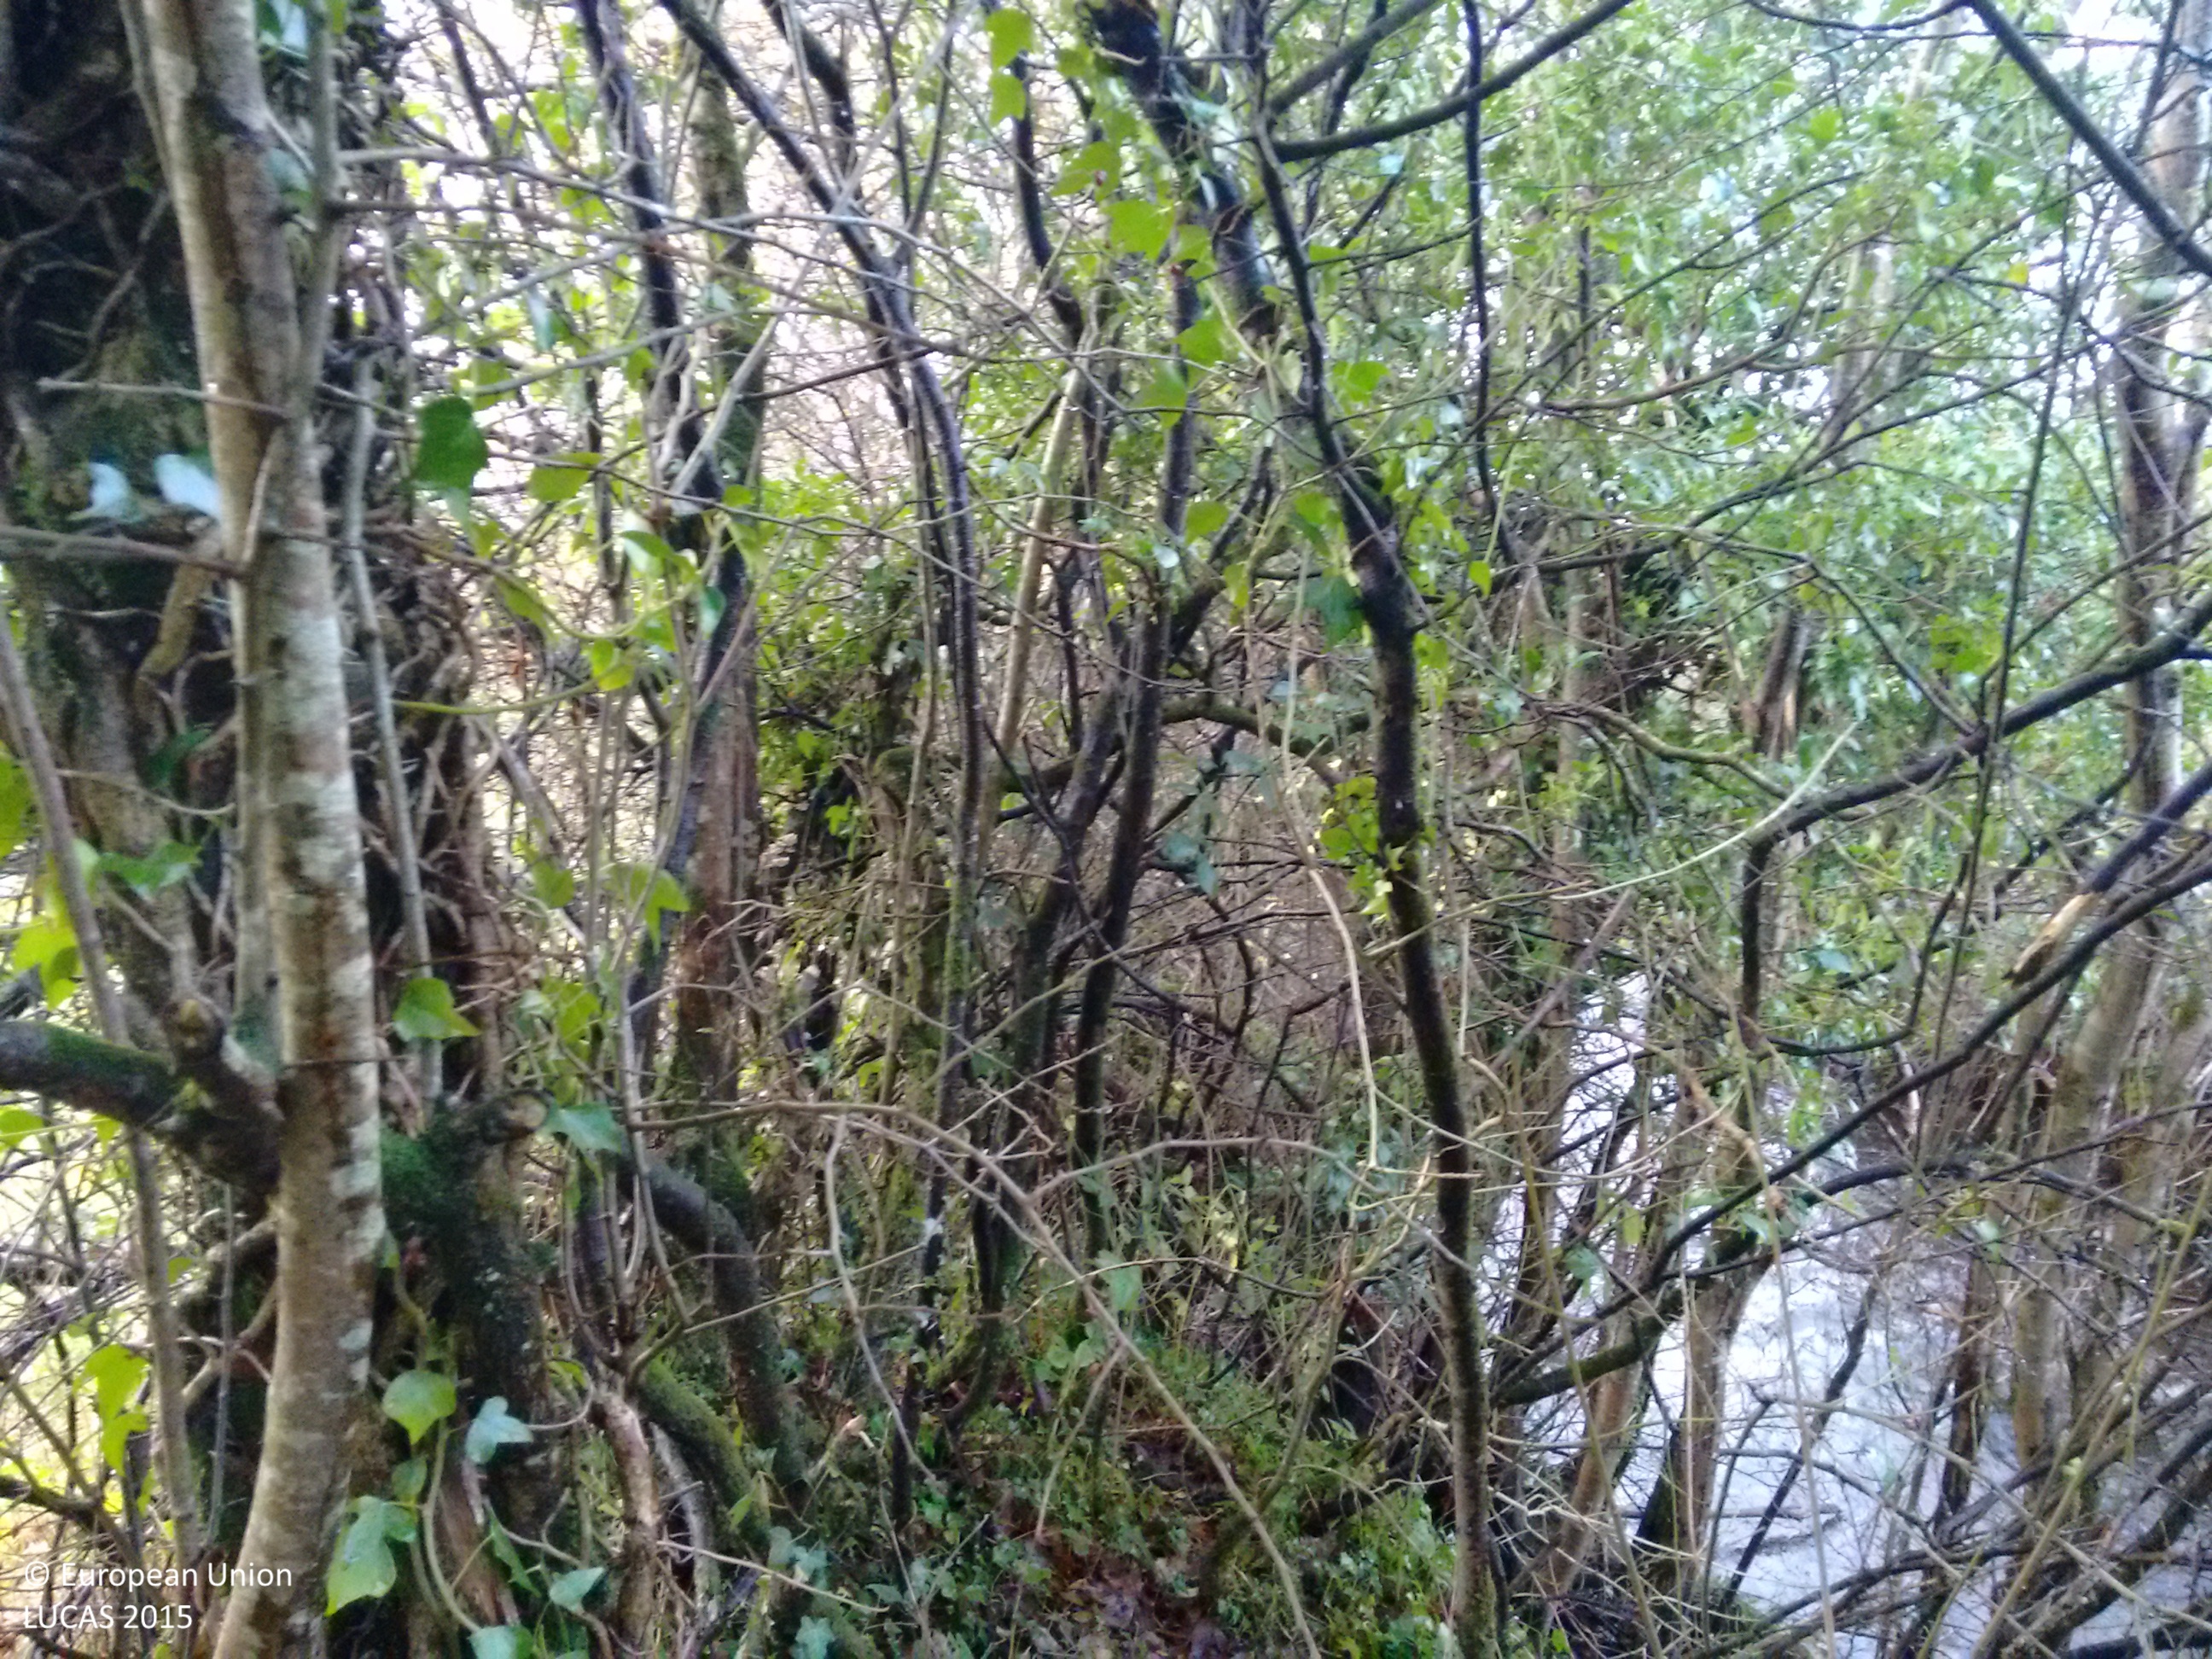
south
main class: Grassland
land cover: Grassland without tree/shrub cover
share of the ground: > 75 %
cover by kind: herbaceous plants 100 %
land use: Agriculture (excluding fallow land and kitchen gardens)
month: December
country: IE
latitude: 54.2134
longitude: -8.0077
